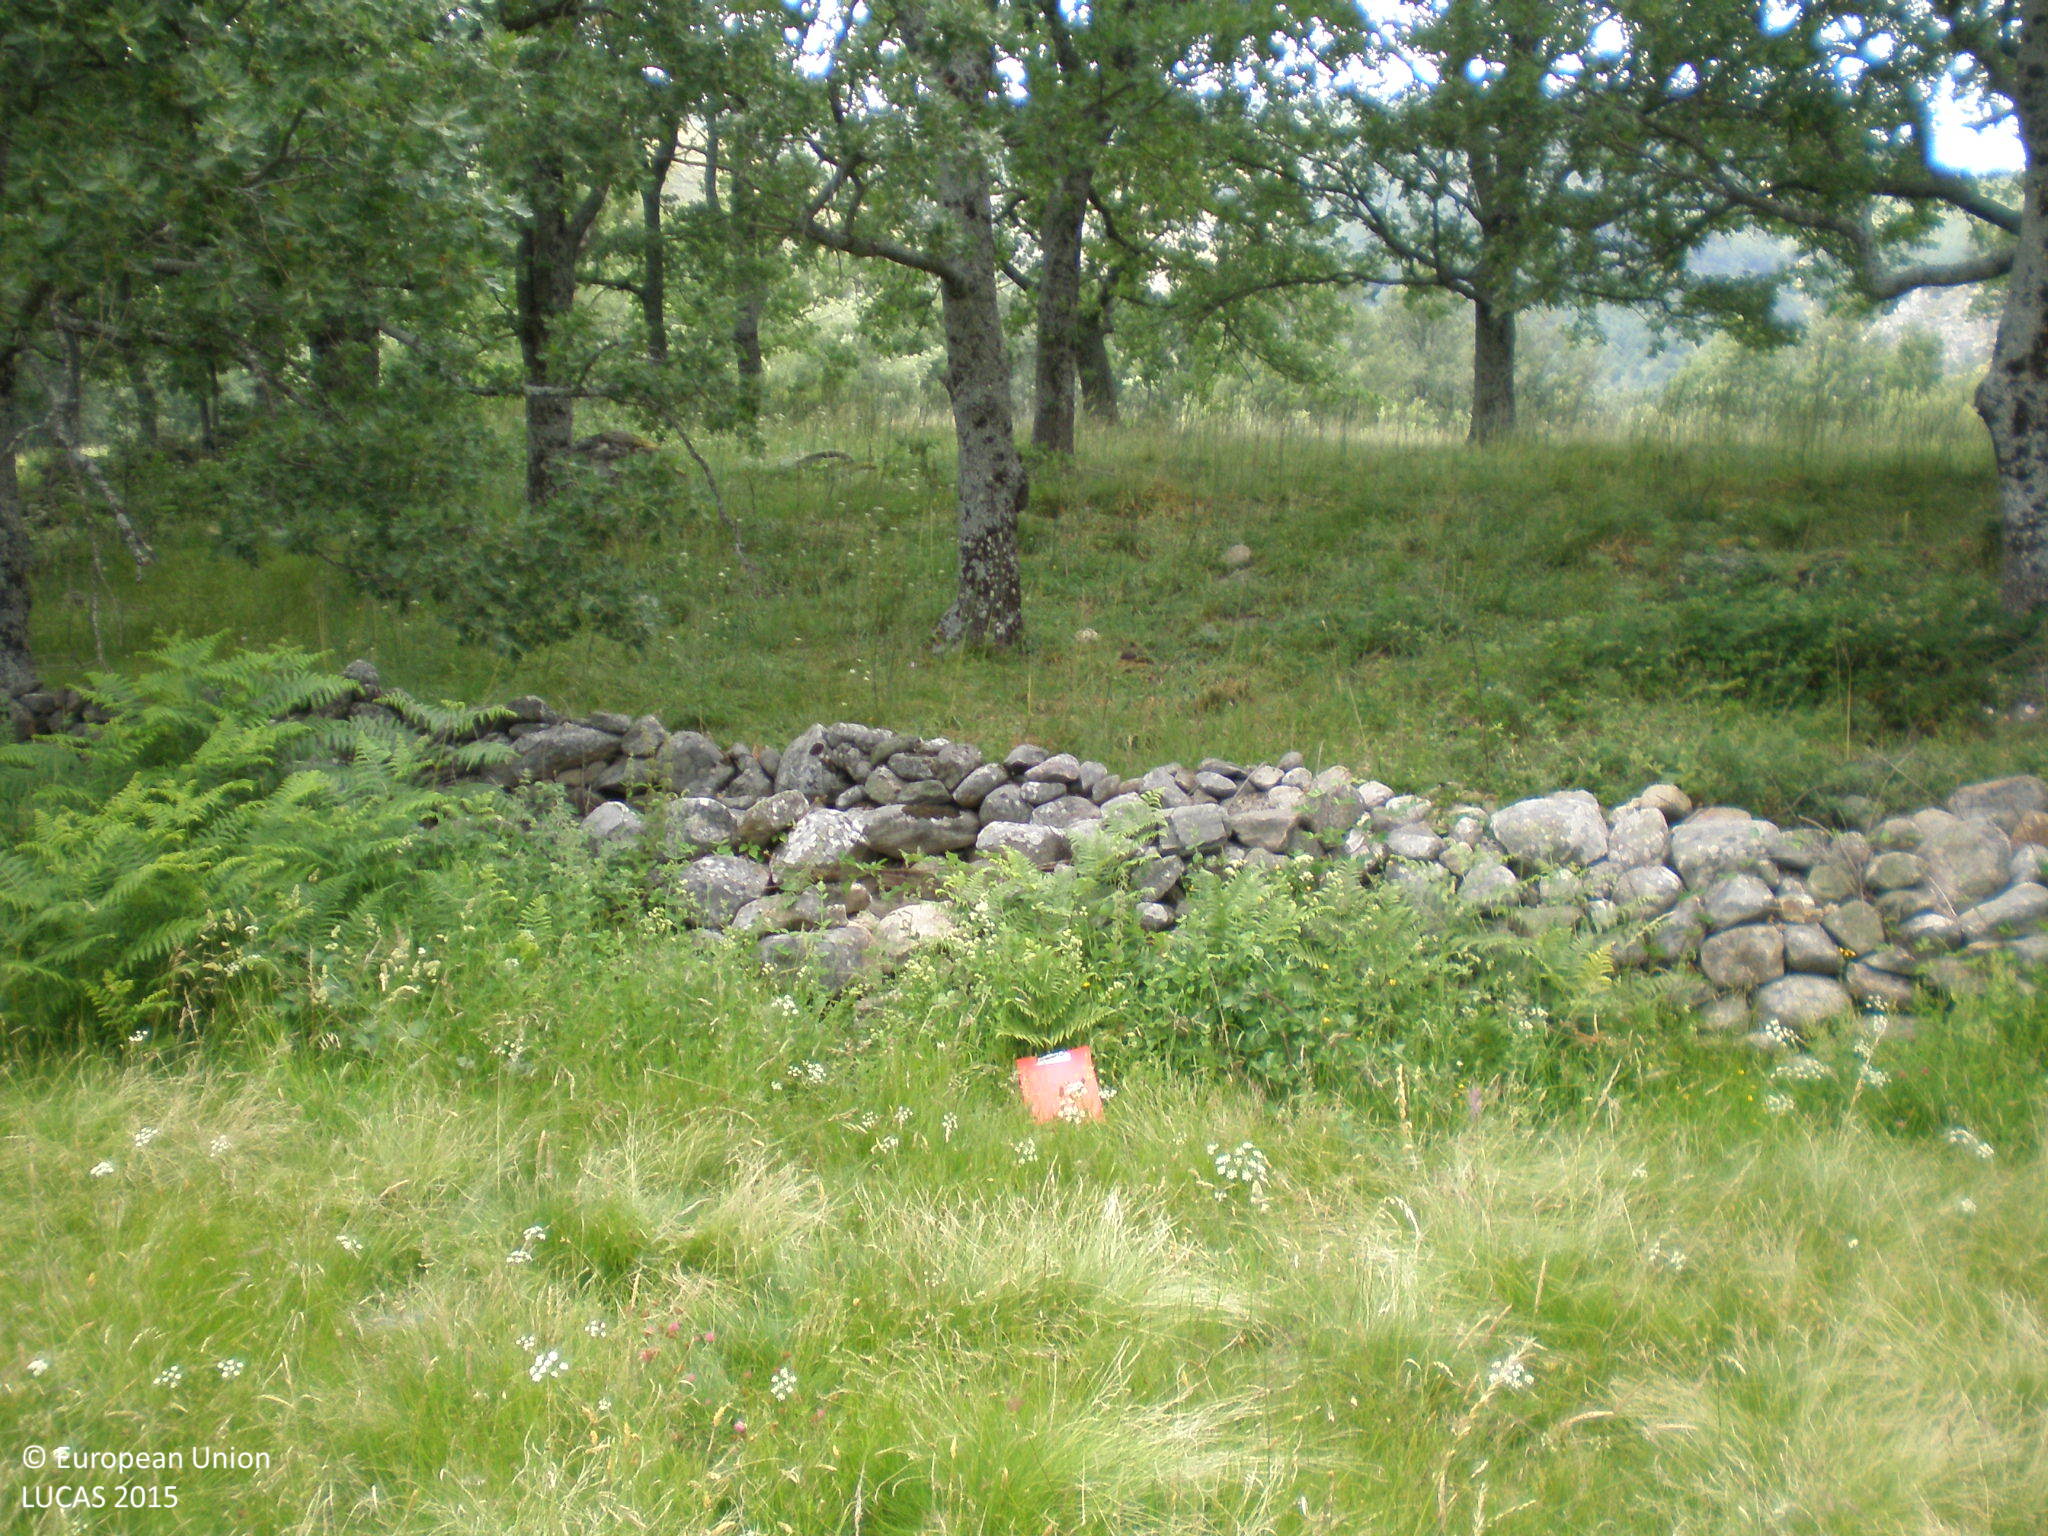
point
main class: Grassland
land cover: Grassland without tree/shrub cover
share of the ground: > 75 %
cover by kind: herbaceous plants 100 %
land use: Agriculture (excluding fallow land and kitchen gardens)
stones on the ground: < 10 %
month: June
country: ES
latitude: 40.2547
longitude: -5.5247
